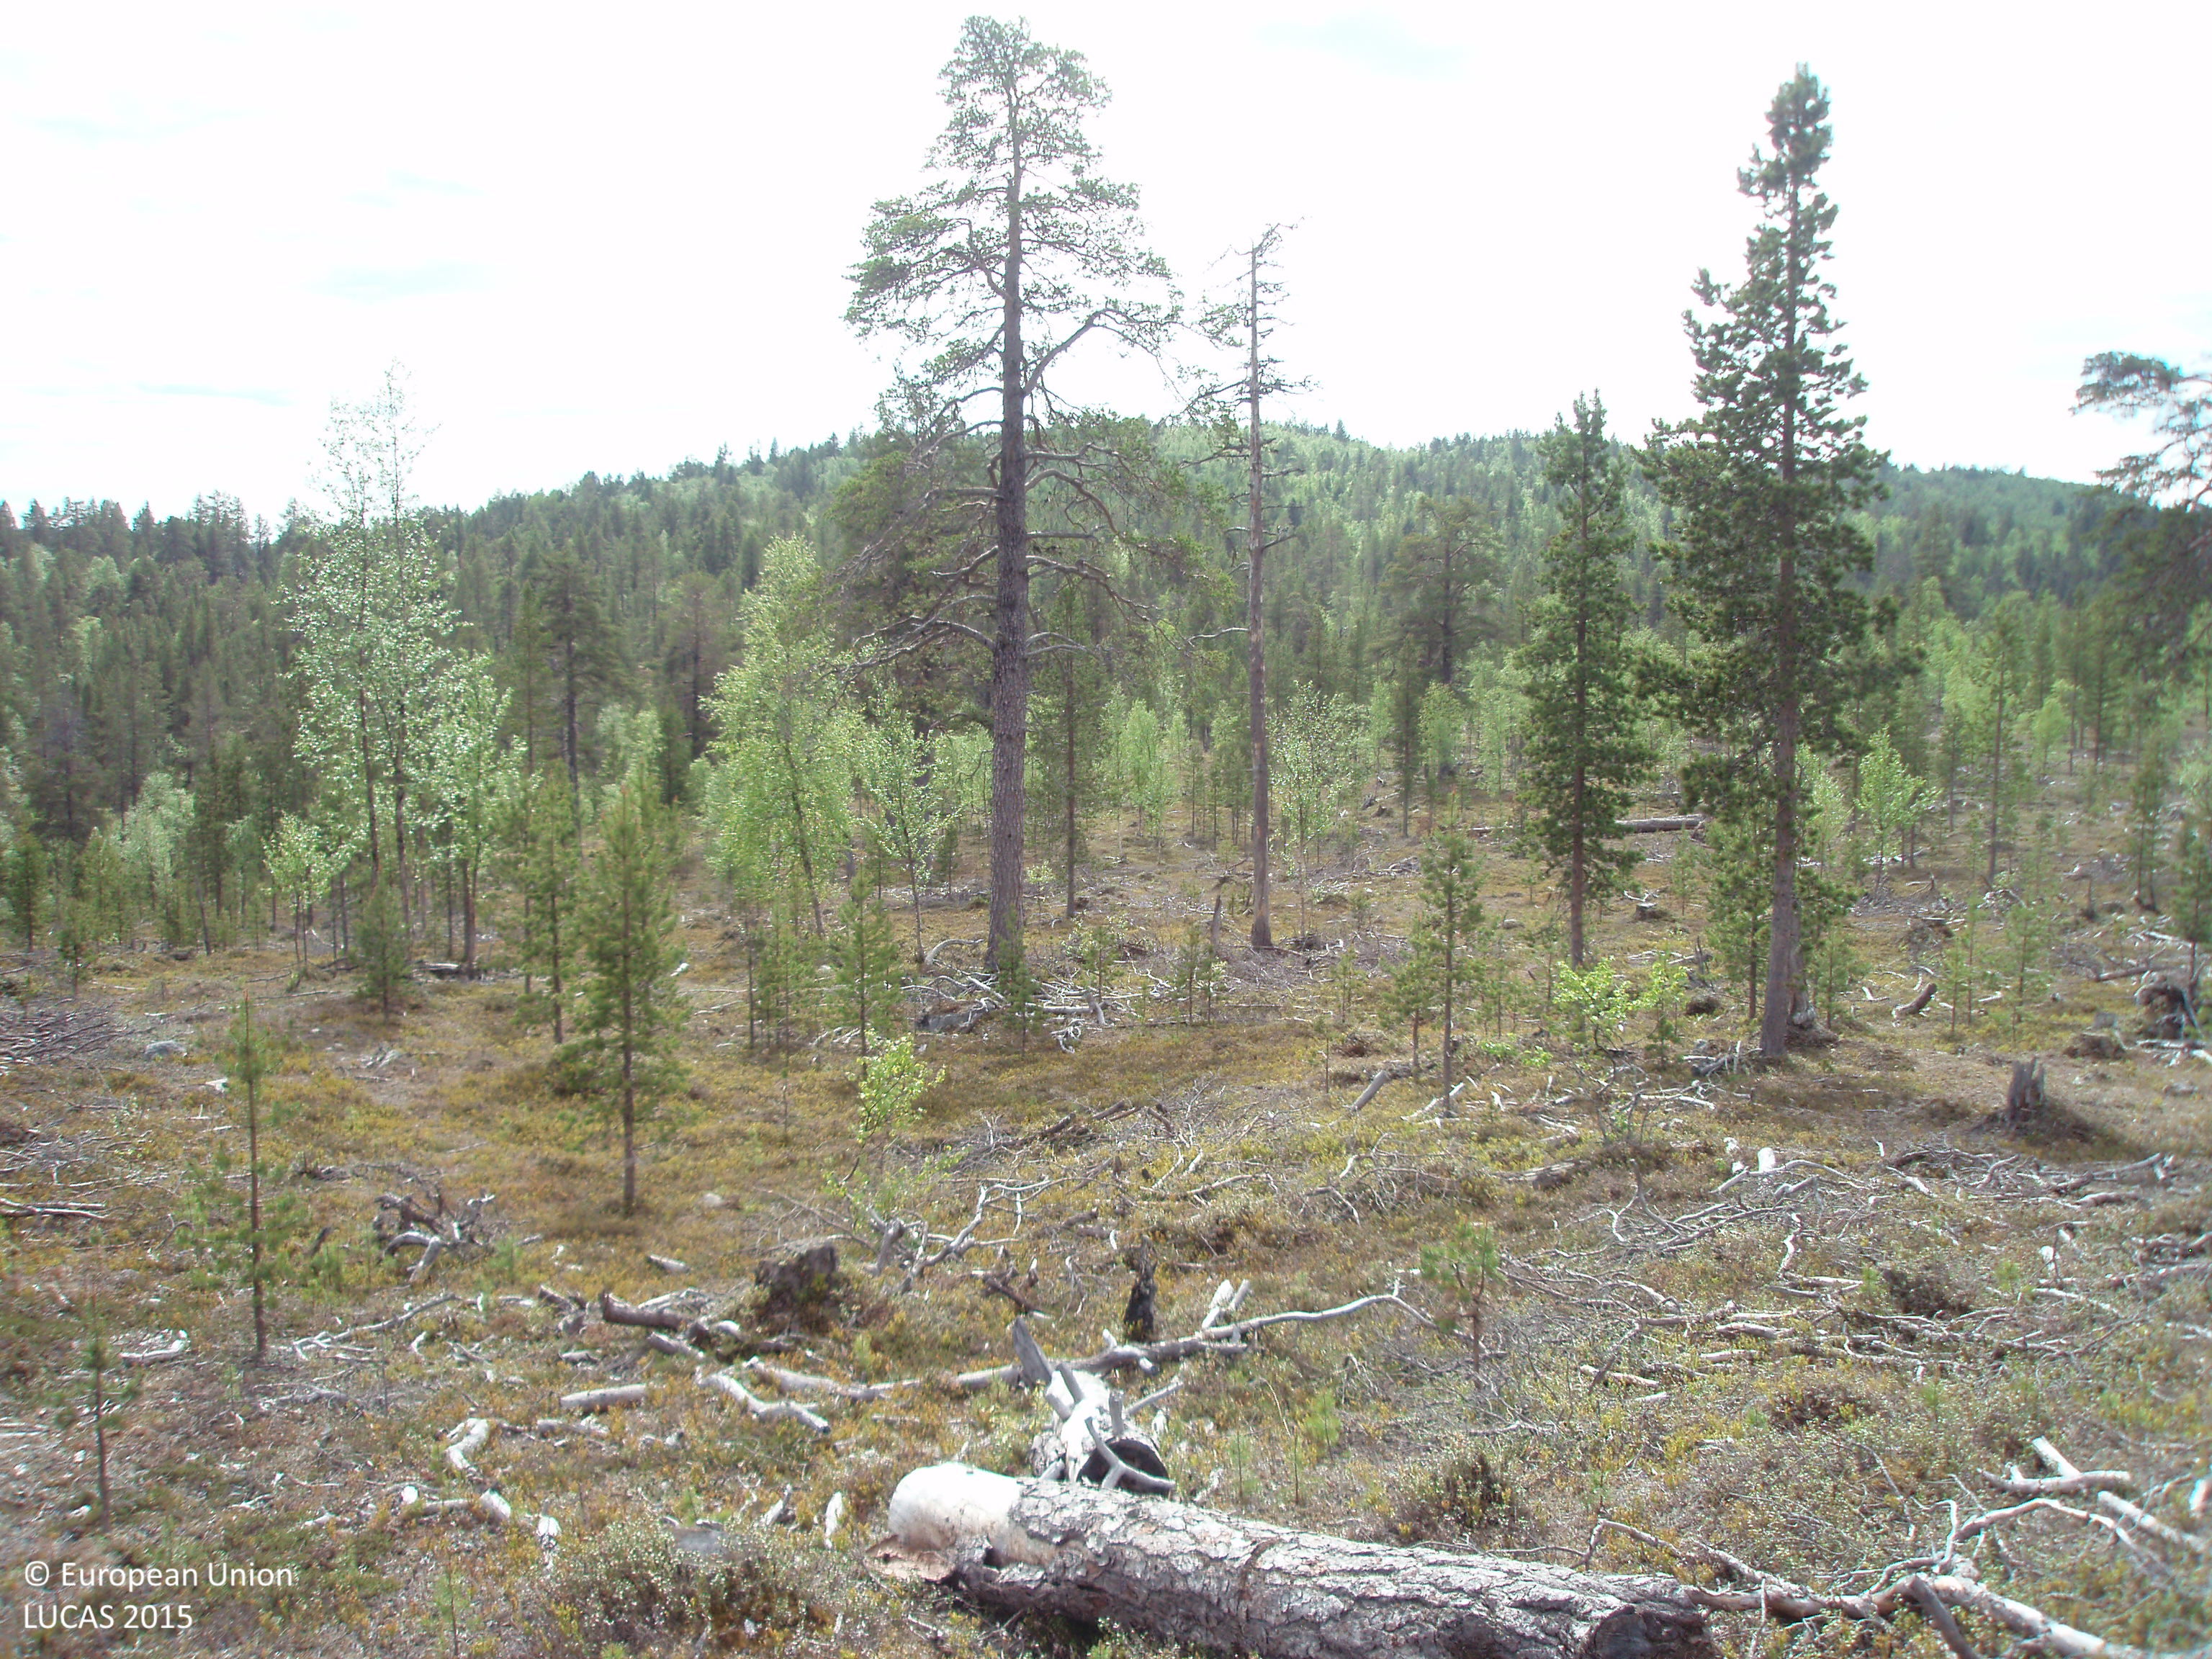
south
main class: Shrubland
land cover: Shrubland with sparse tree cover
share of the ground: > 75 %
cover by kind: shrubs 85 %, coniferous forest trees 5 %, lichens and mosses 5 %, unconsolidated bare surface 5 %
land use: Forestry
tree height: < 5 m
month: June
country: FI
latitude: 68.7971
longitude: 26.6271
